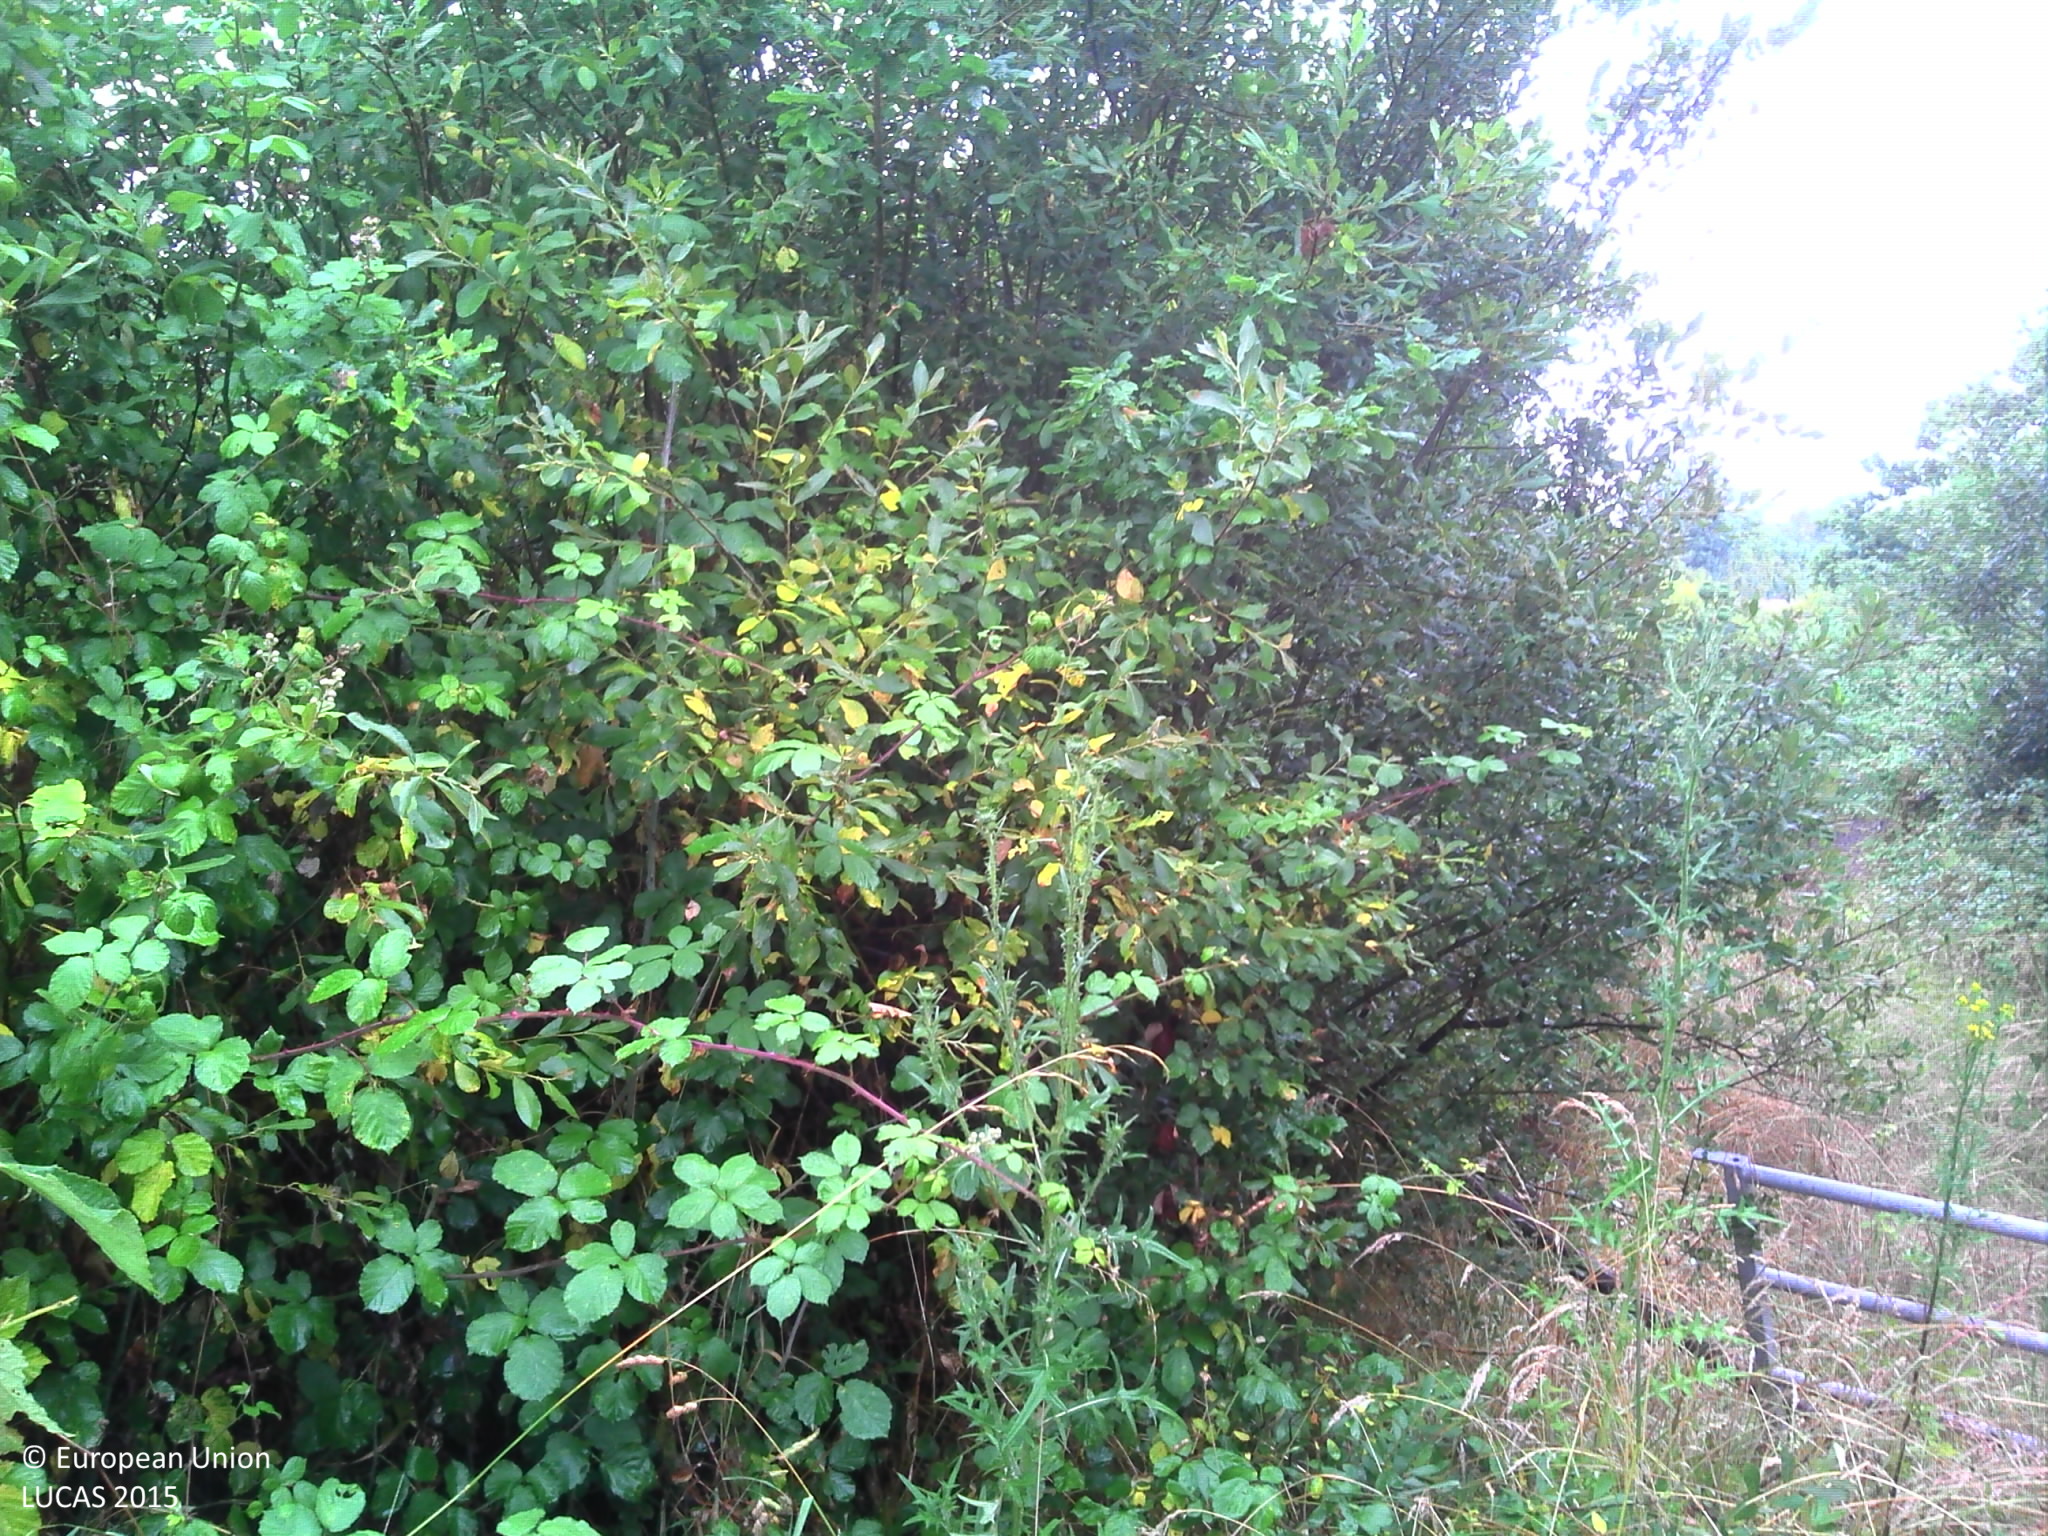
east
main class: Shrubland
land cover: Shrubland with sparse tree cover
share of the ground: > 75 %
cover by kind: shrubs 95 %, broadleaved forest trees 5 %
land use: Road transport
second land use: Semi-natural and natural areas not in use
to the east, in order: Shrubland with sparse tree cover; Grass margins; Fences; Grass margins; Paved roads, cycling and walking lanes; Grass margins; Spontaneously vegetated surfaces; Ditches and canals; Fences; Grassland without tree/shrub cover; Ditches and canals; Grassland without tree/shrub cover
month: July
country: FR
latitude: 47.1988
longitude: -1.8602
